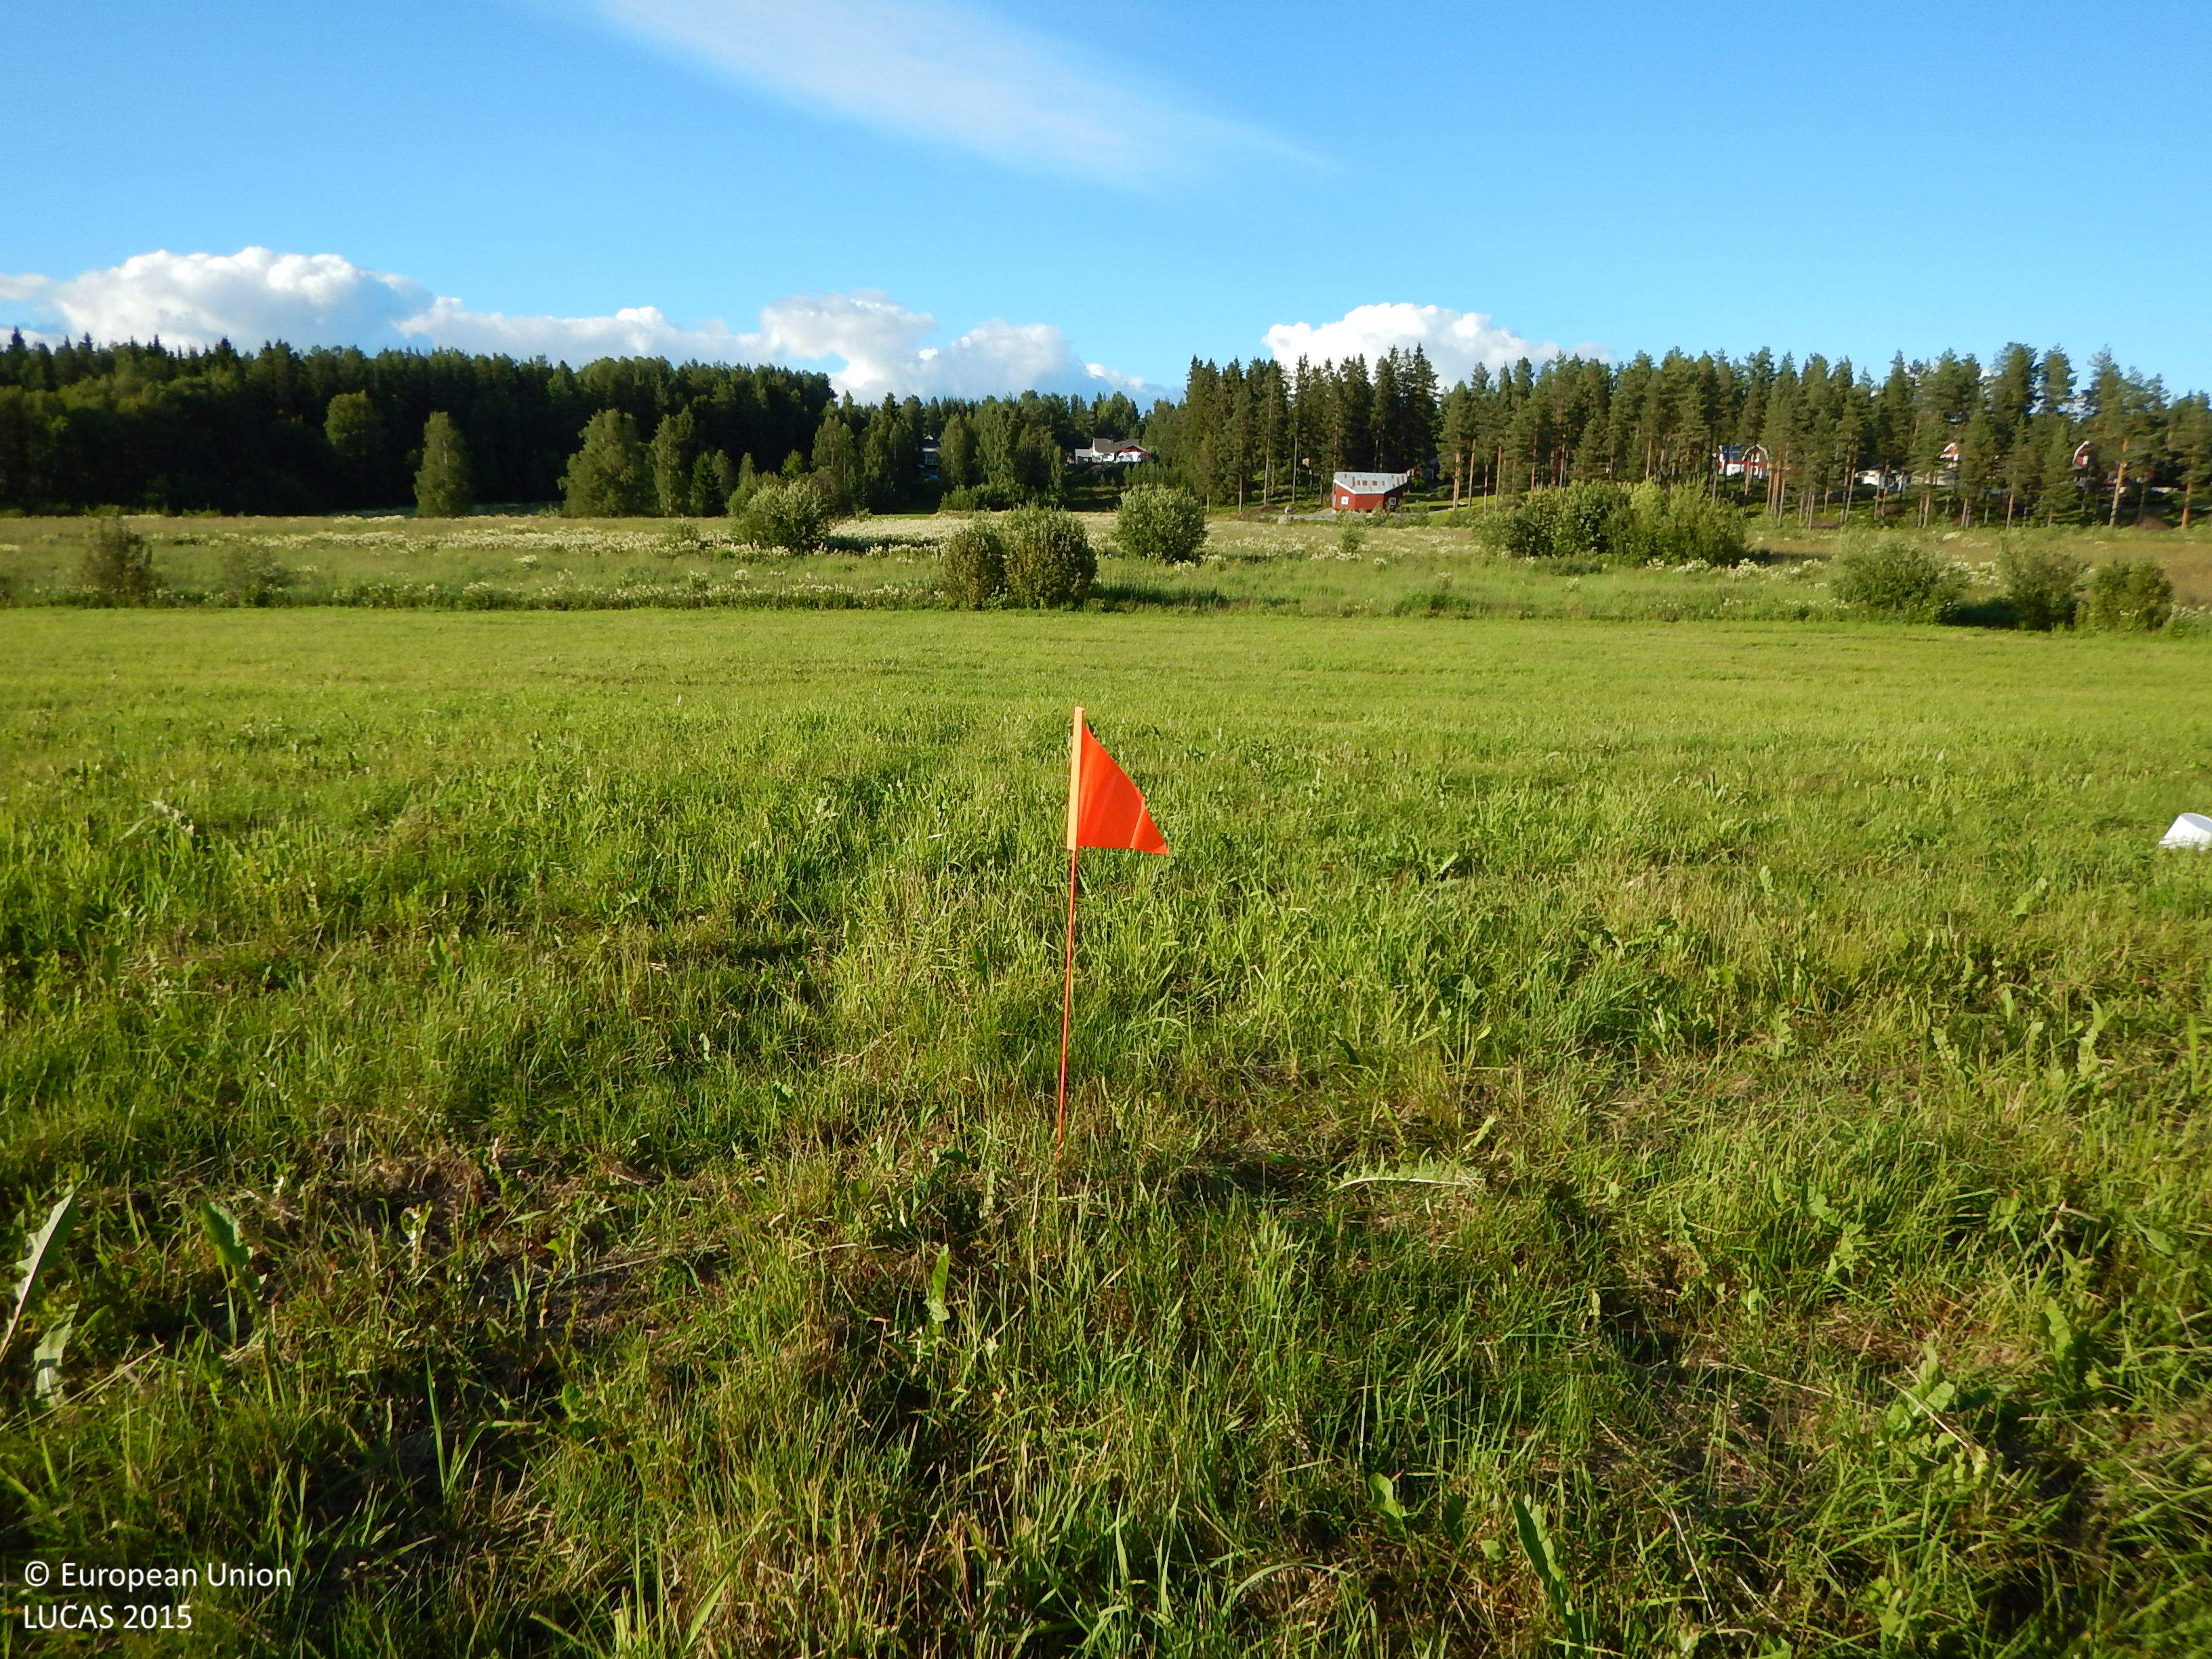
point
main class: Grassland
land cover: Grassland without tree/shrub cover
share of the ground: > 75 %
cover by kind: herbaceous plants 100 %
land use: Agriculture (excluding fallow land and kitchen gardens)
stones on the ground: < 10 %
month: July
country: SE
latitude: 64.7715
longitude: 20.8904
